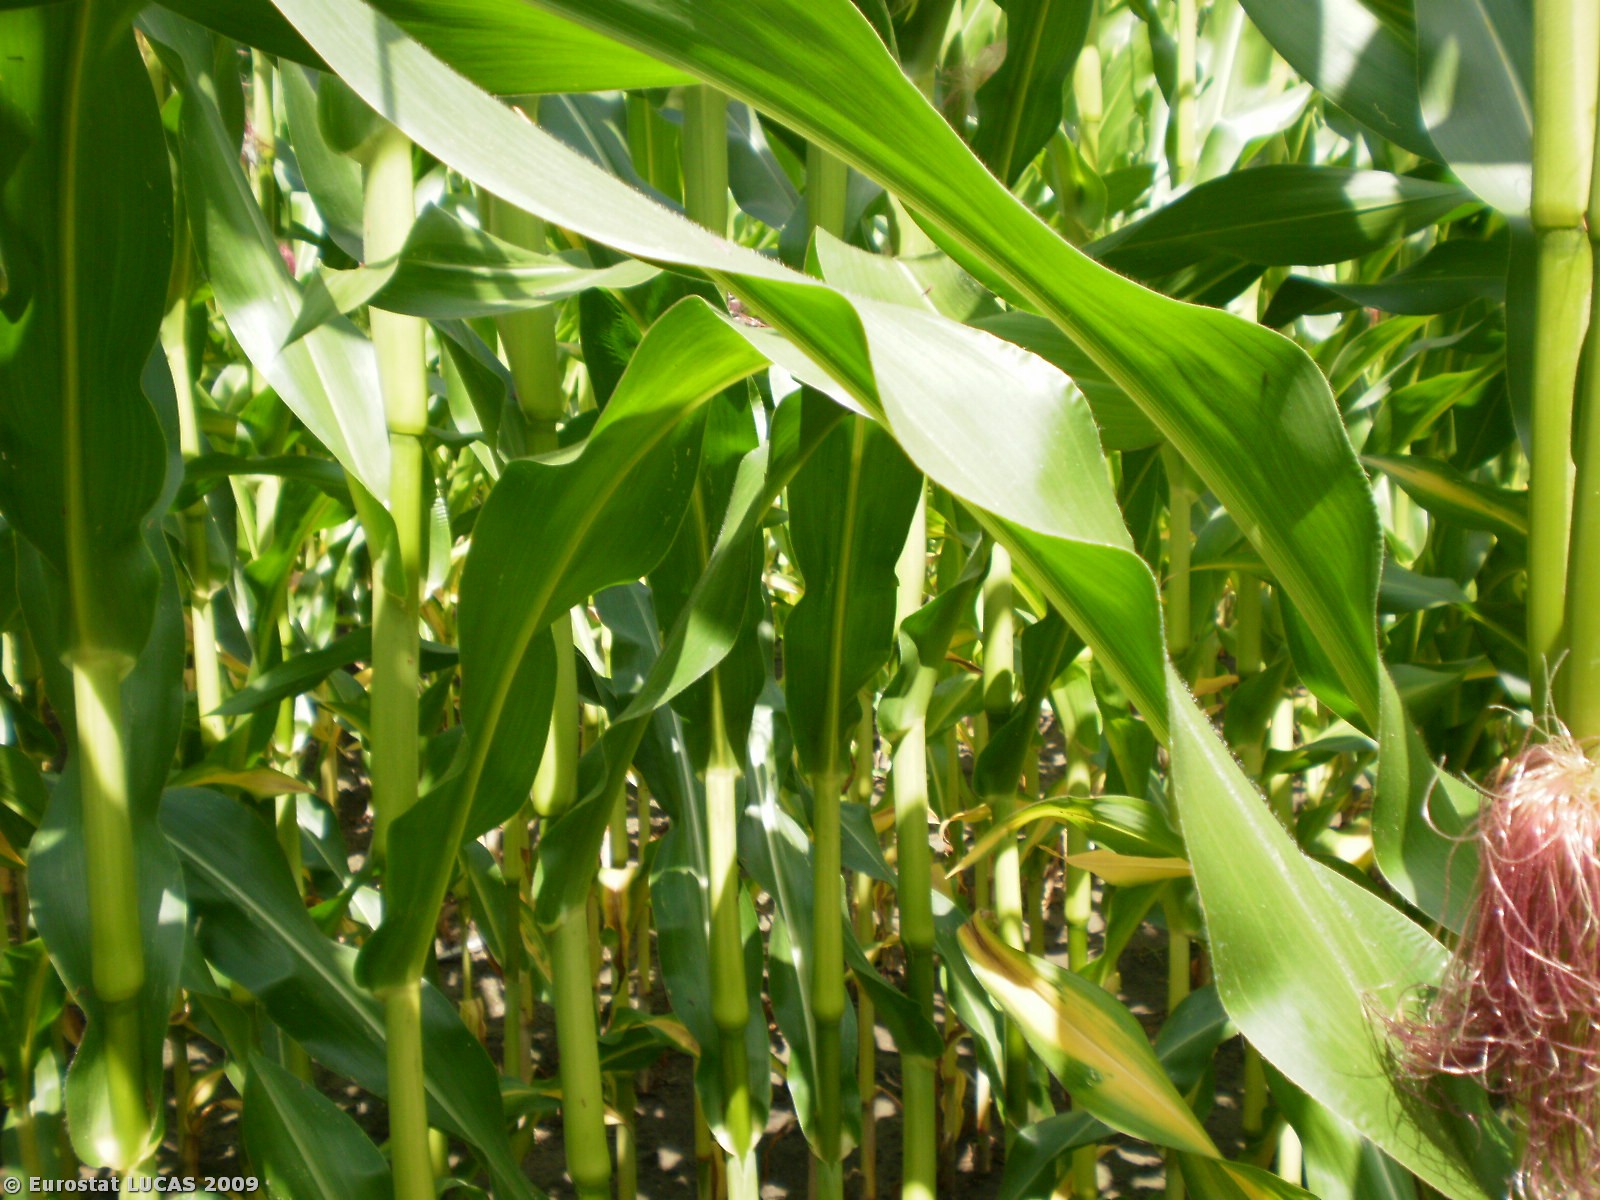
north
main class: Cropland
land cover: Maize
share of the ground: > 75 %
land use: Agriculture (excluding fallow land and kitchen gardens)
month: July
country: BE
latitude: 51.0112
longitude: 4.2224
